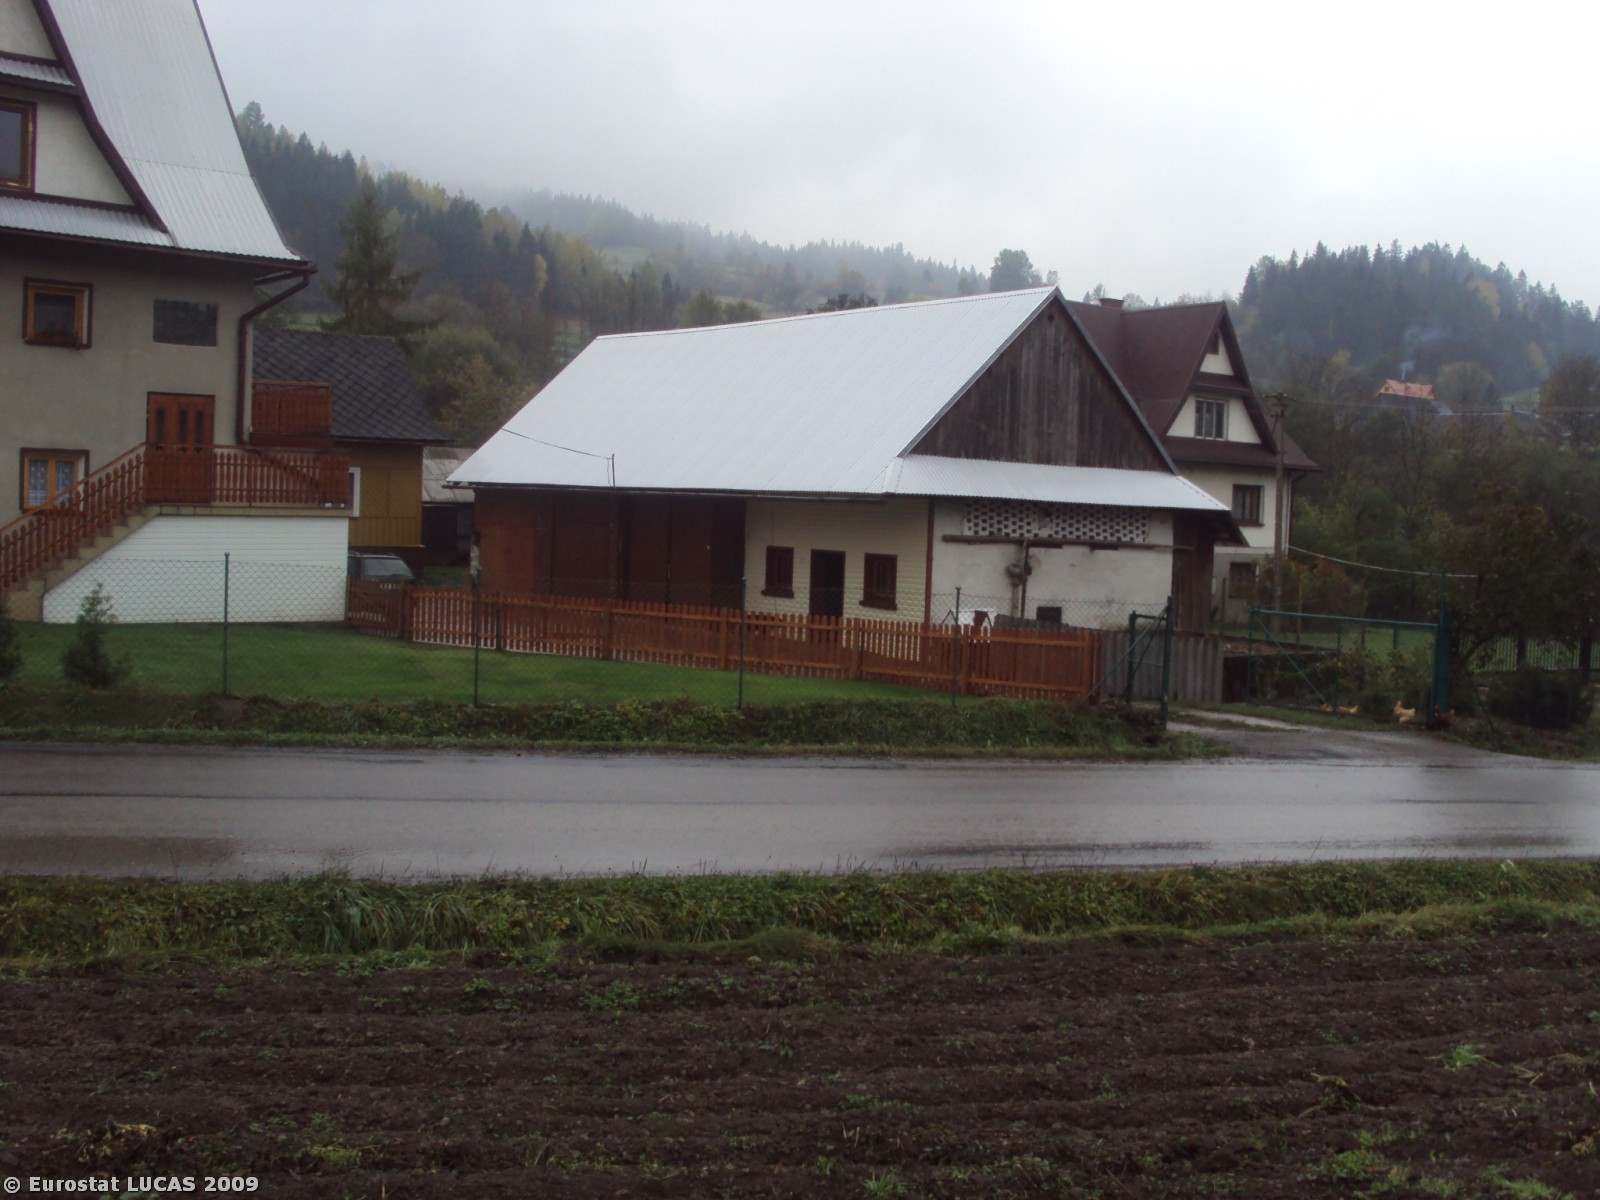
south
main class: Grassland
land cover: Grassland without tree/shrub cover
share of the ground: > 75 %
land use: Agriculture (excluding fallow land and kitchen gardens)
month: September
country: PL
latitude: 49.6770
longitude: 20.1358
